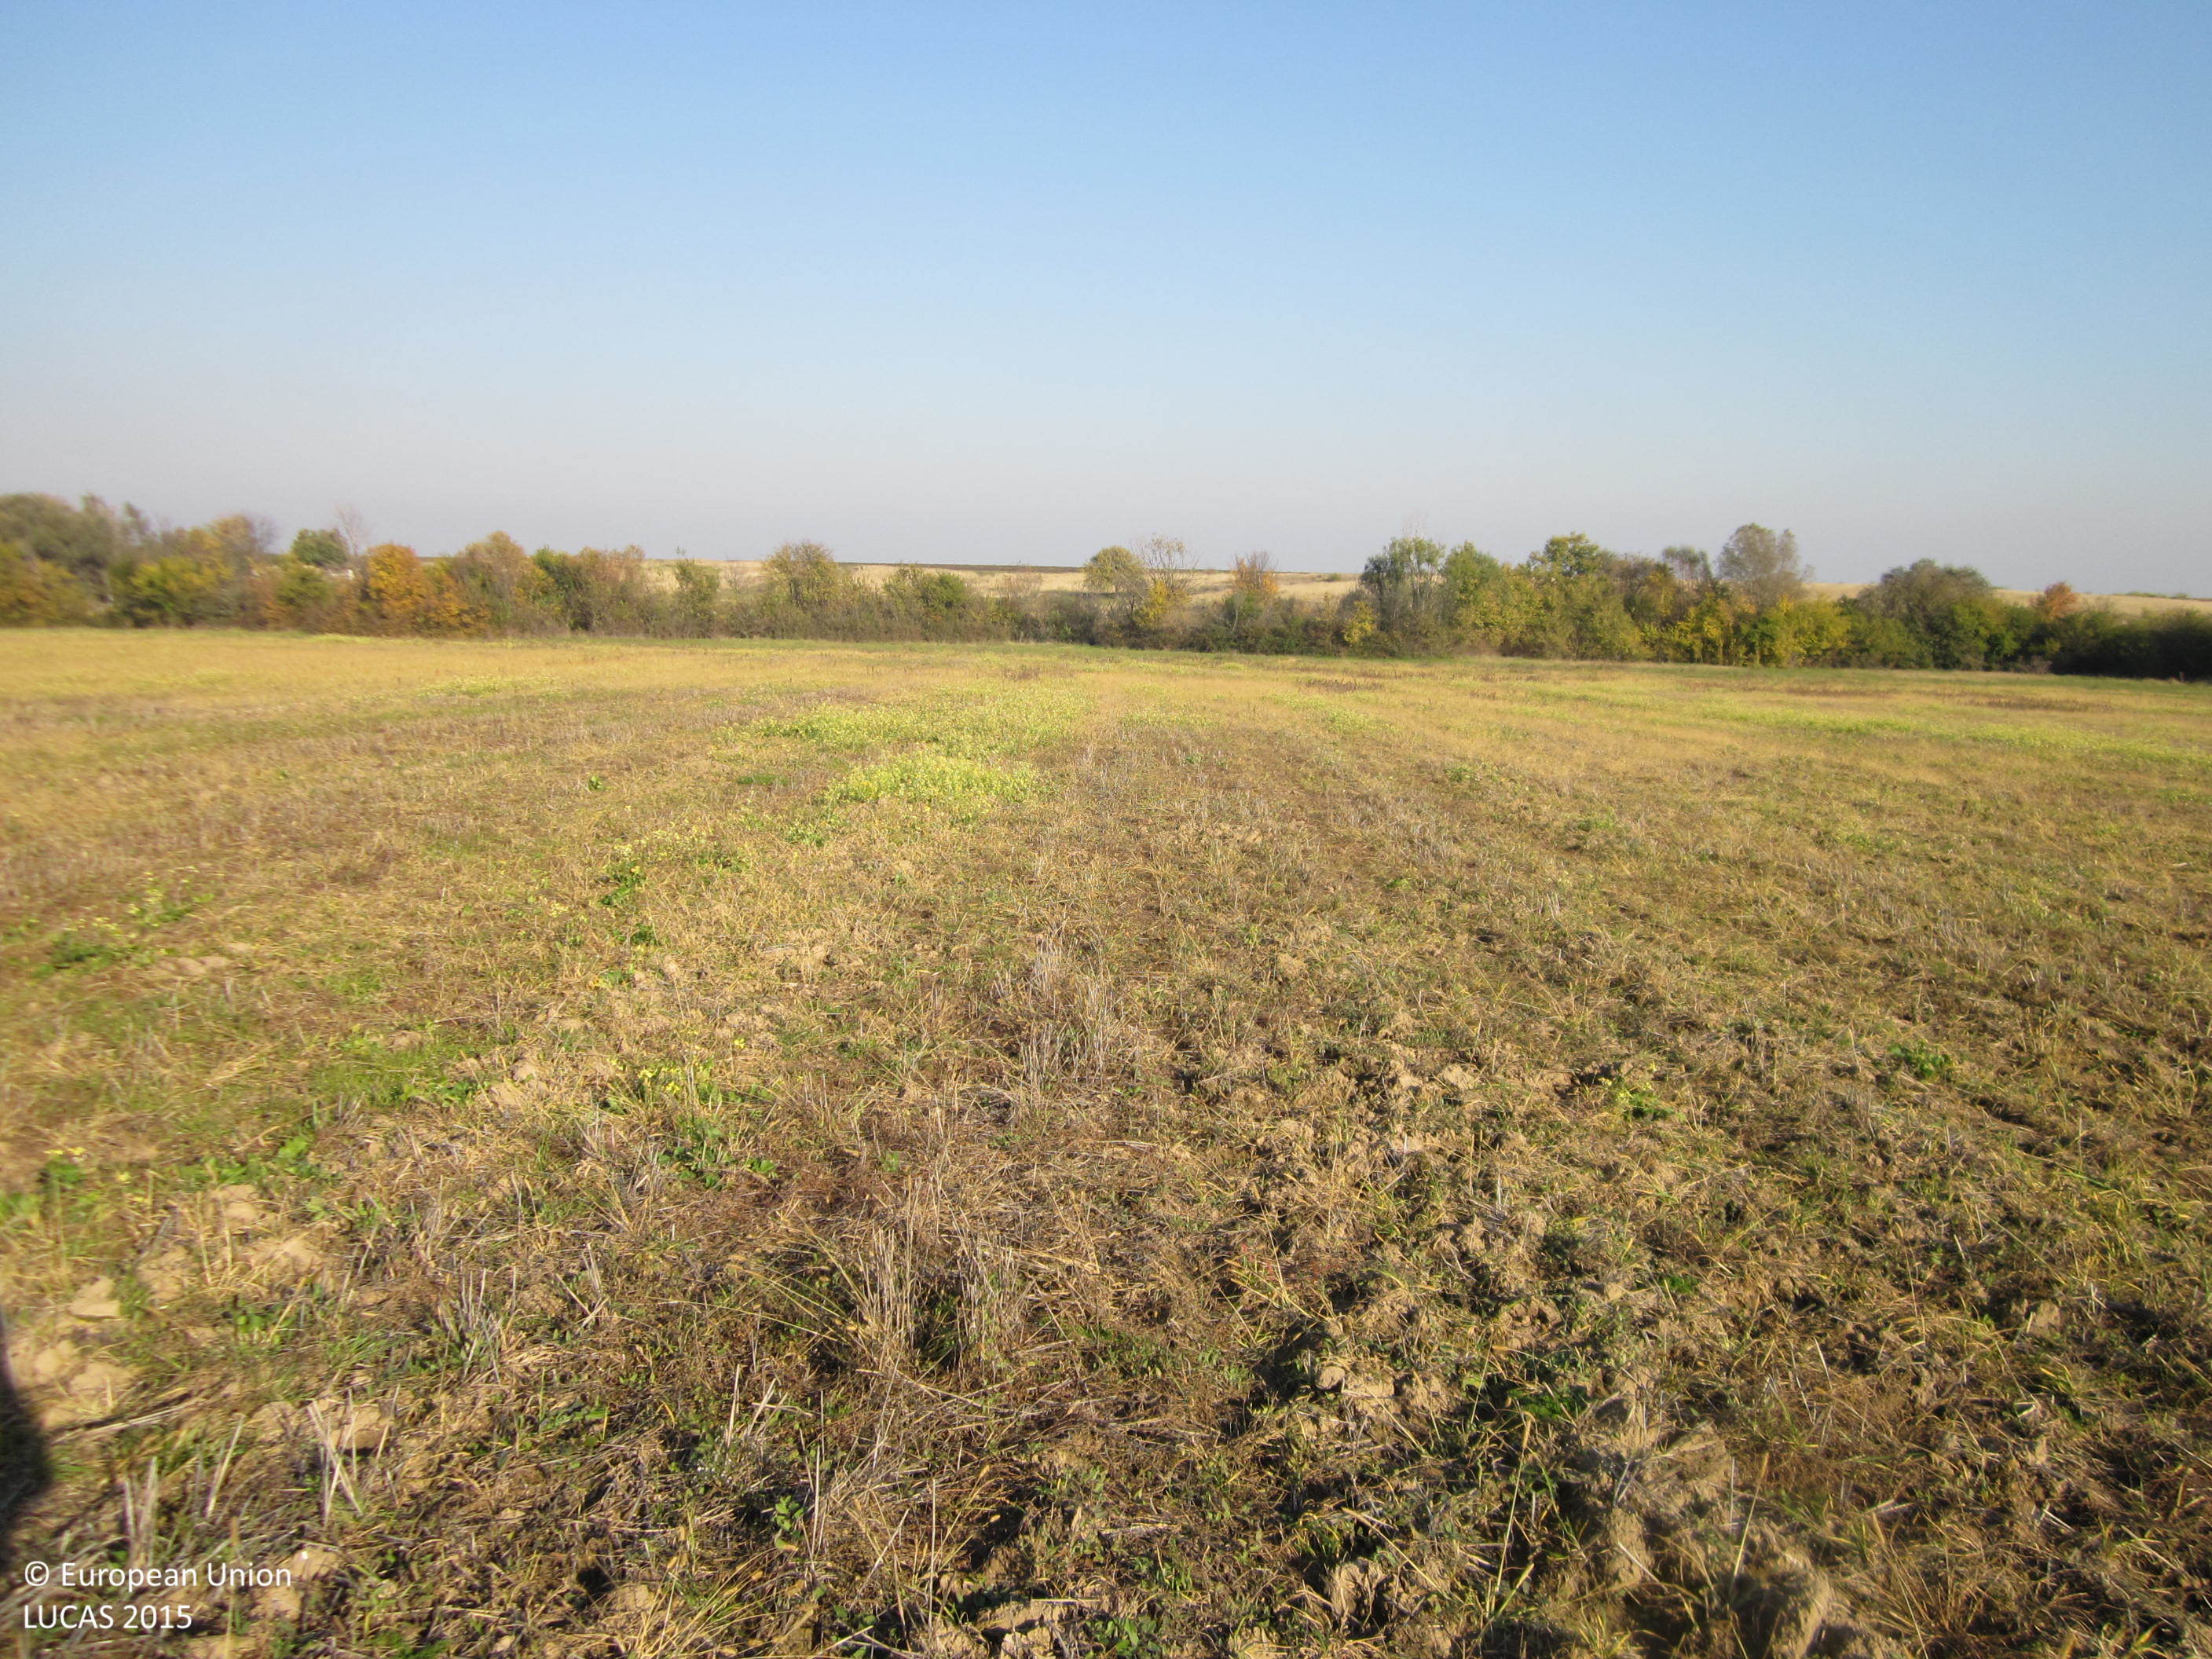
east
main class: Cropland
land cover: Common wheat
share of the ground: 10 - 25 %
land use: Agriculture (excluding fallow land and kitchen gardens)
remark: Tilled/Sowed
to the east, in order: Common wheat; Grassland without tree/shrub cover; Abandoned hedges; Inland fresh water bodies; Abandoned hedges; Grassland without tree/shrub cover; Tracks; Grassland without tree/shrub cover
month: November
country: BG
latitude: 42.4181
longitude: 24.6976
